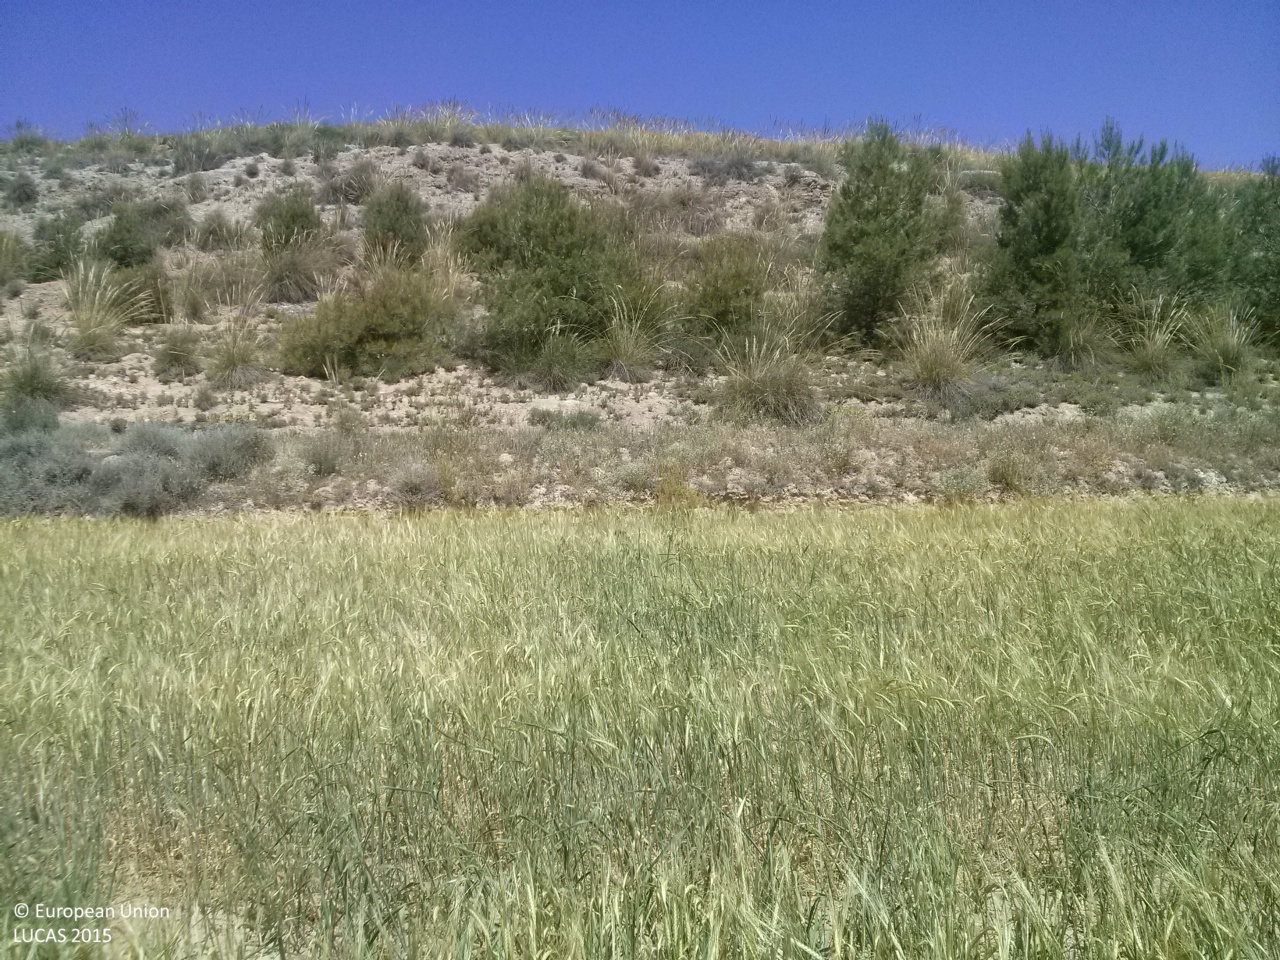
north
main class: Cropland
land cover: Barley
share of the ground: > 75 %
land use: Agriculture (excluding fallow land and kitchen gardens)
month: May
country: ES
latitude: 40.2570
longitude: -2.7337
